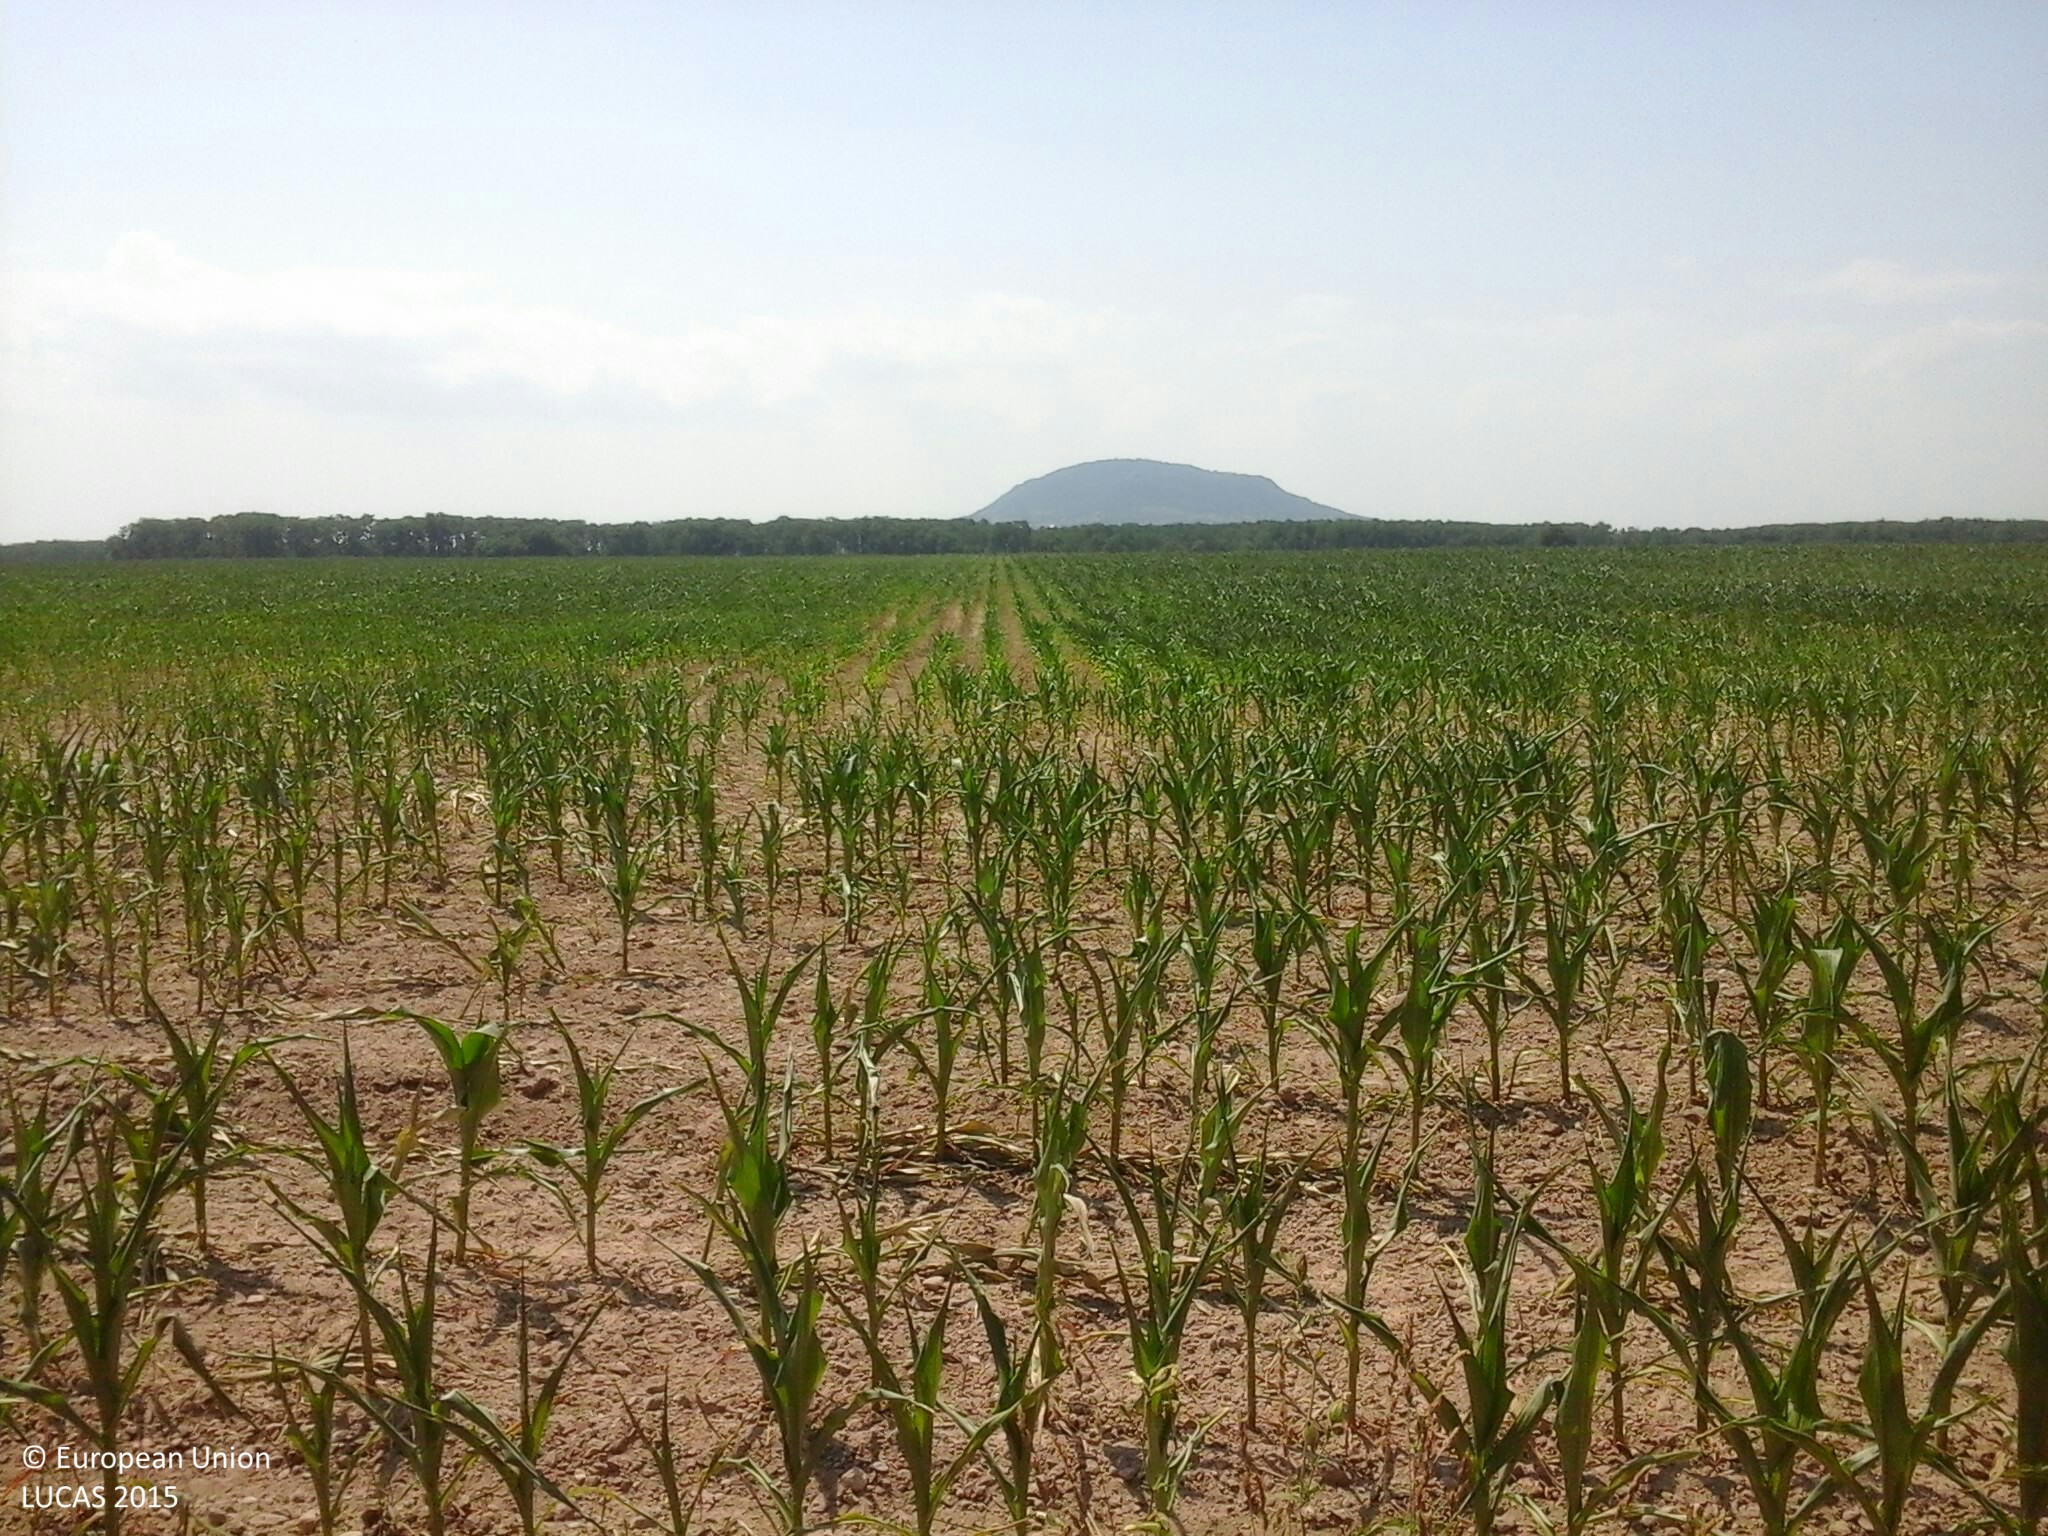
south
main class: Shrubland
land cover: Shrubland with sparse tree cover
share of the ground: 50 - 75 %
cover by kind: herbaceous plants 50 %, shrubs 45 %, broadleaved forest trees 5 %
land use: Semi-natural and natural areas not in use
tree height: < 5 m
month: July
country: HU
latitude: 47.2004
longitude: 17.3591
